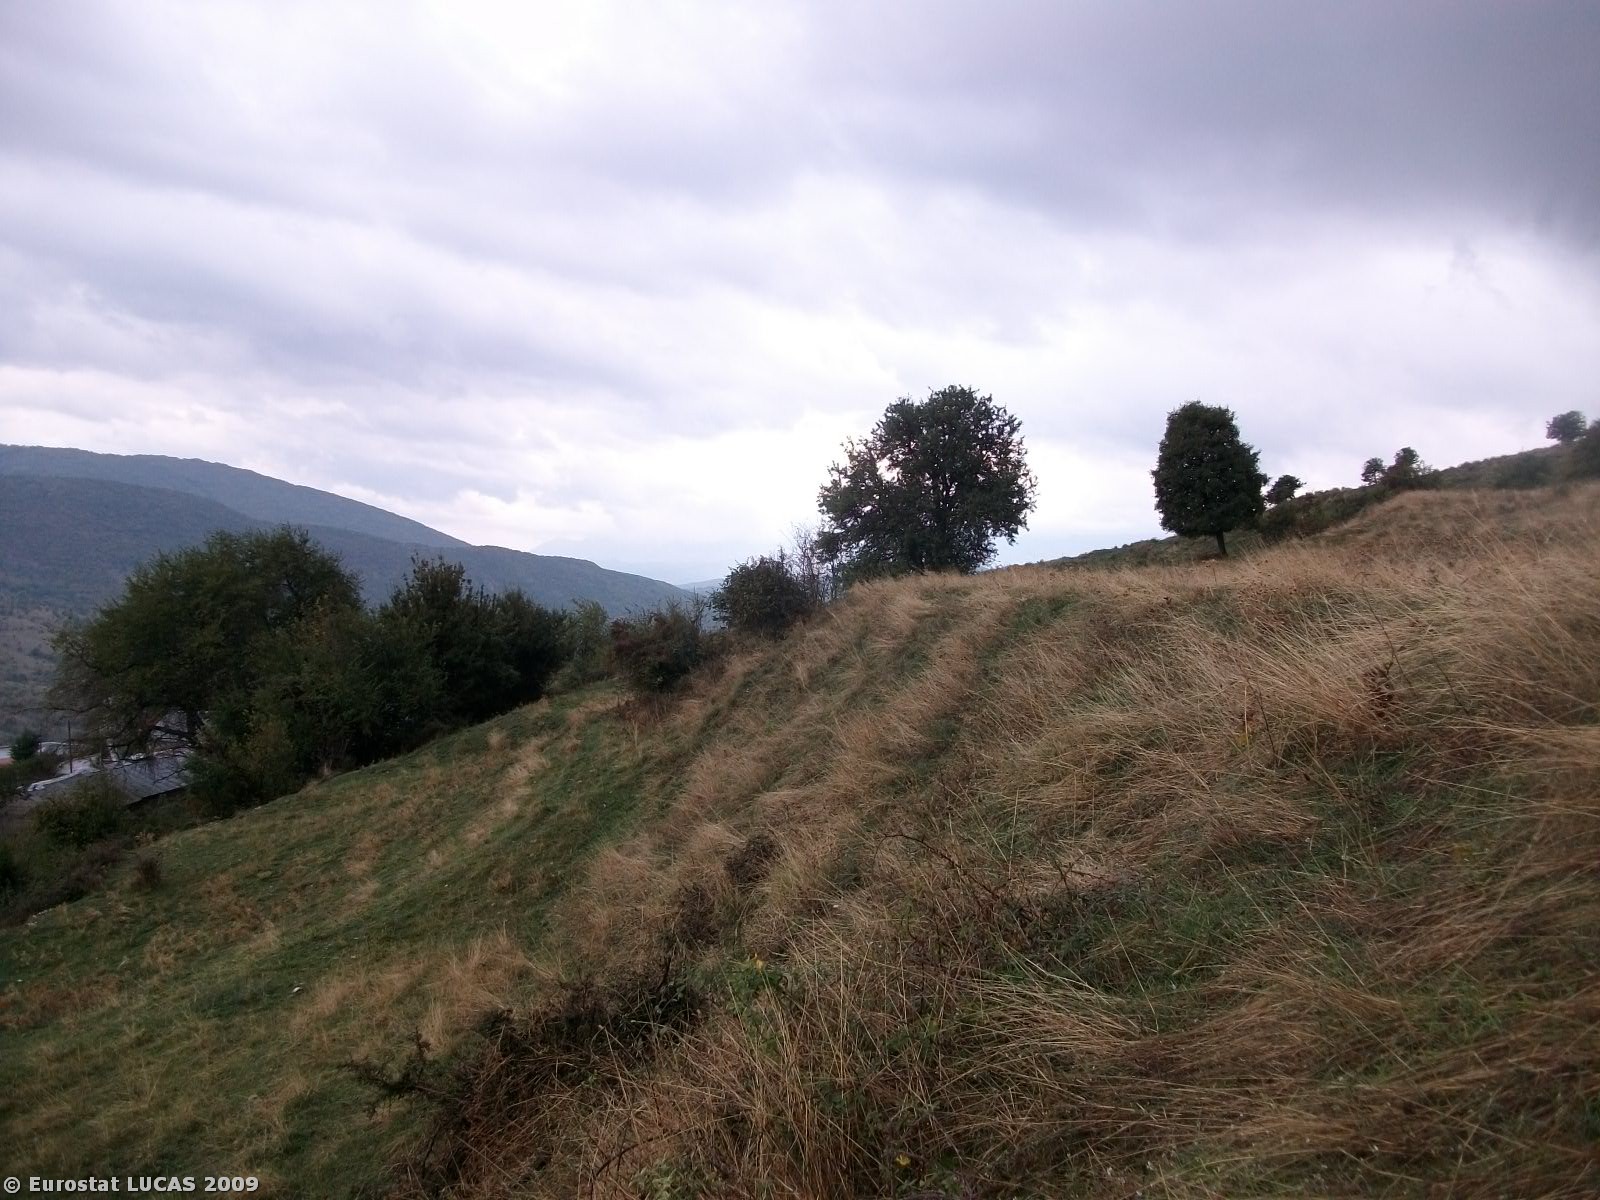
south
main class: Grassland
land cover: Grassland without tree/shrub cover
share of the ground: > 75 %
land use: Agriculture (excluding fallow land and kitchen gardens)
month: October
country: GR
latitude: 40.0030
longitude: 20.4165
